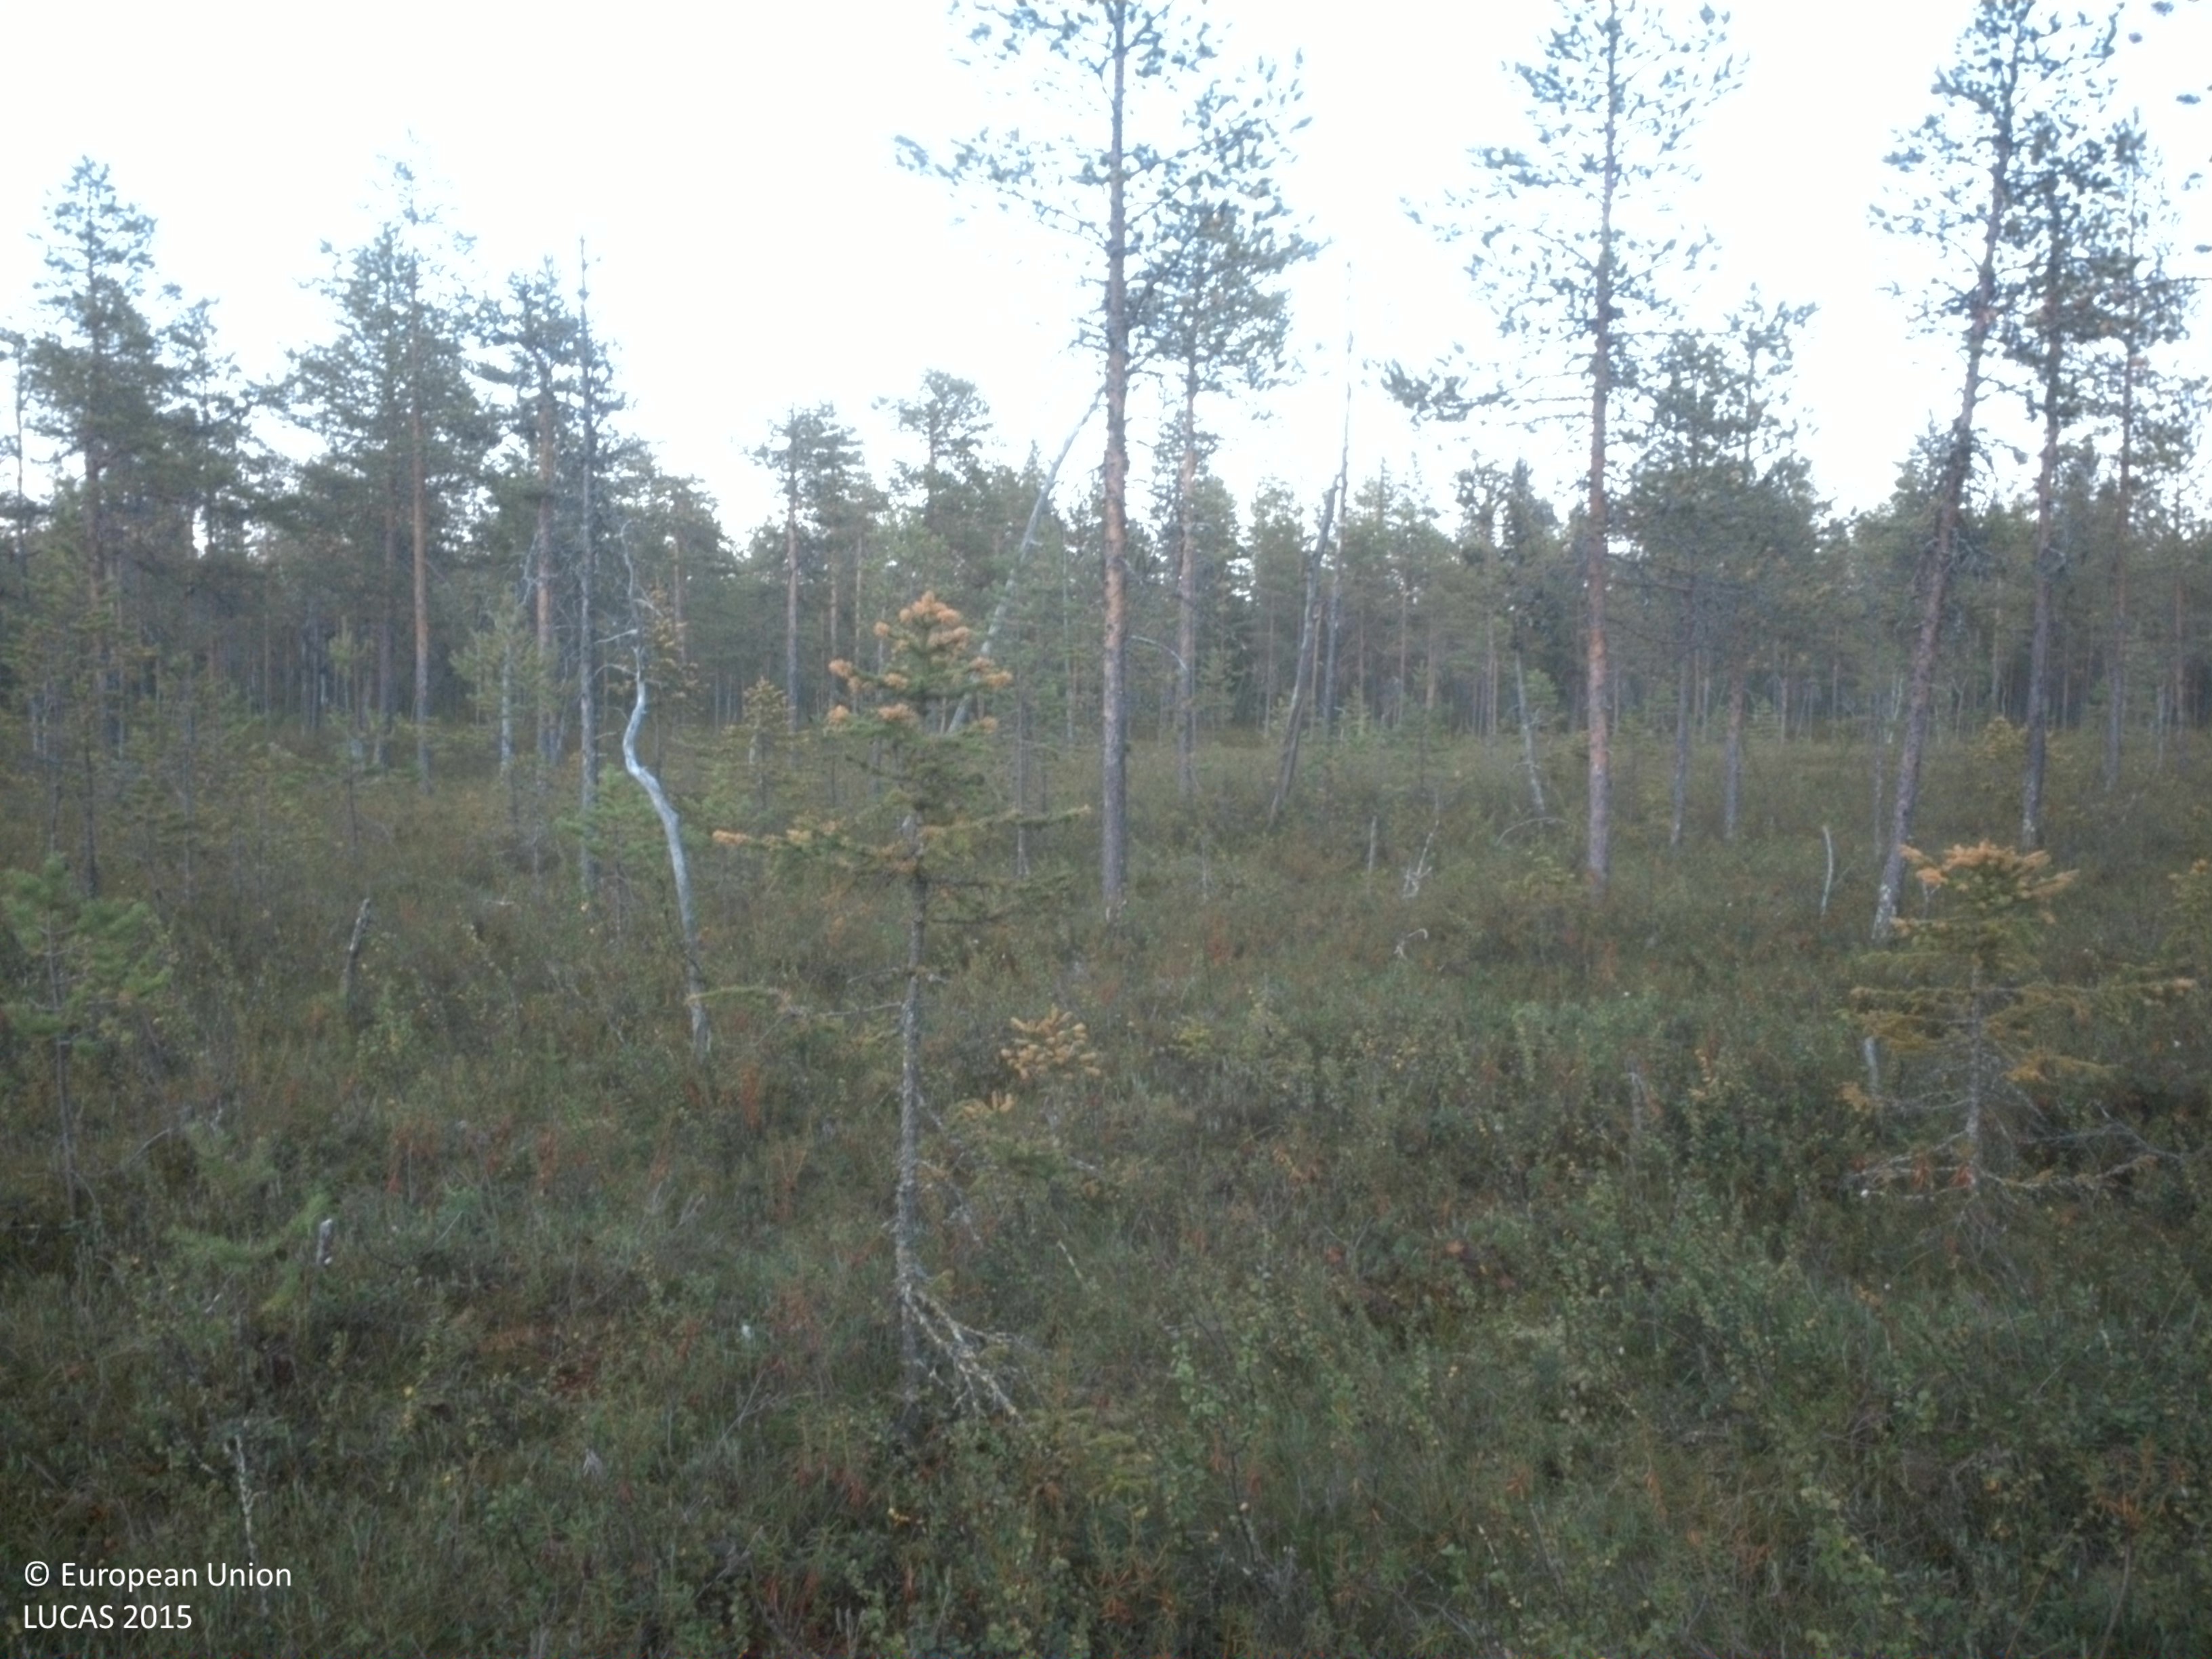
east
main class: Woodland
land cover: Pine dominated coniferous woodland
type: boreal forest
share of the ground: 10 - 25 %
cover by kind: shrubs 30 %, herbaceous plants 30 %, coniferous forest trees 20 %, lichens and mosses 20 %
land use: Forestry
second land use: Other primary production
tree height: > 5 m
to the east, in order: Pine dominated coniferous woodland; Fences; Pine dominated coniferous woodland
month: August
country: SE
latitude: 64.6258
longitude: 18.8150
